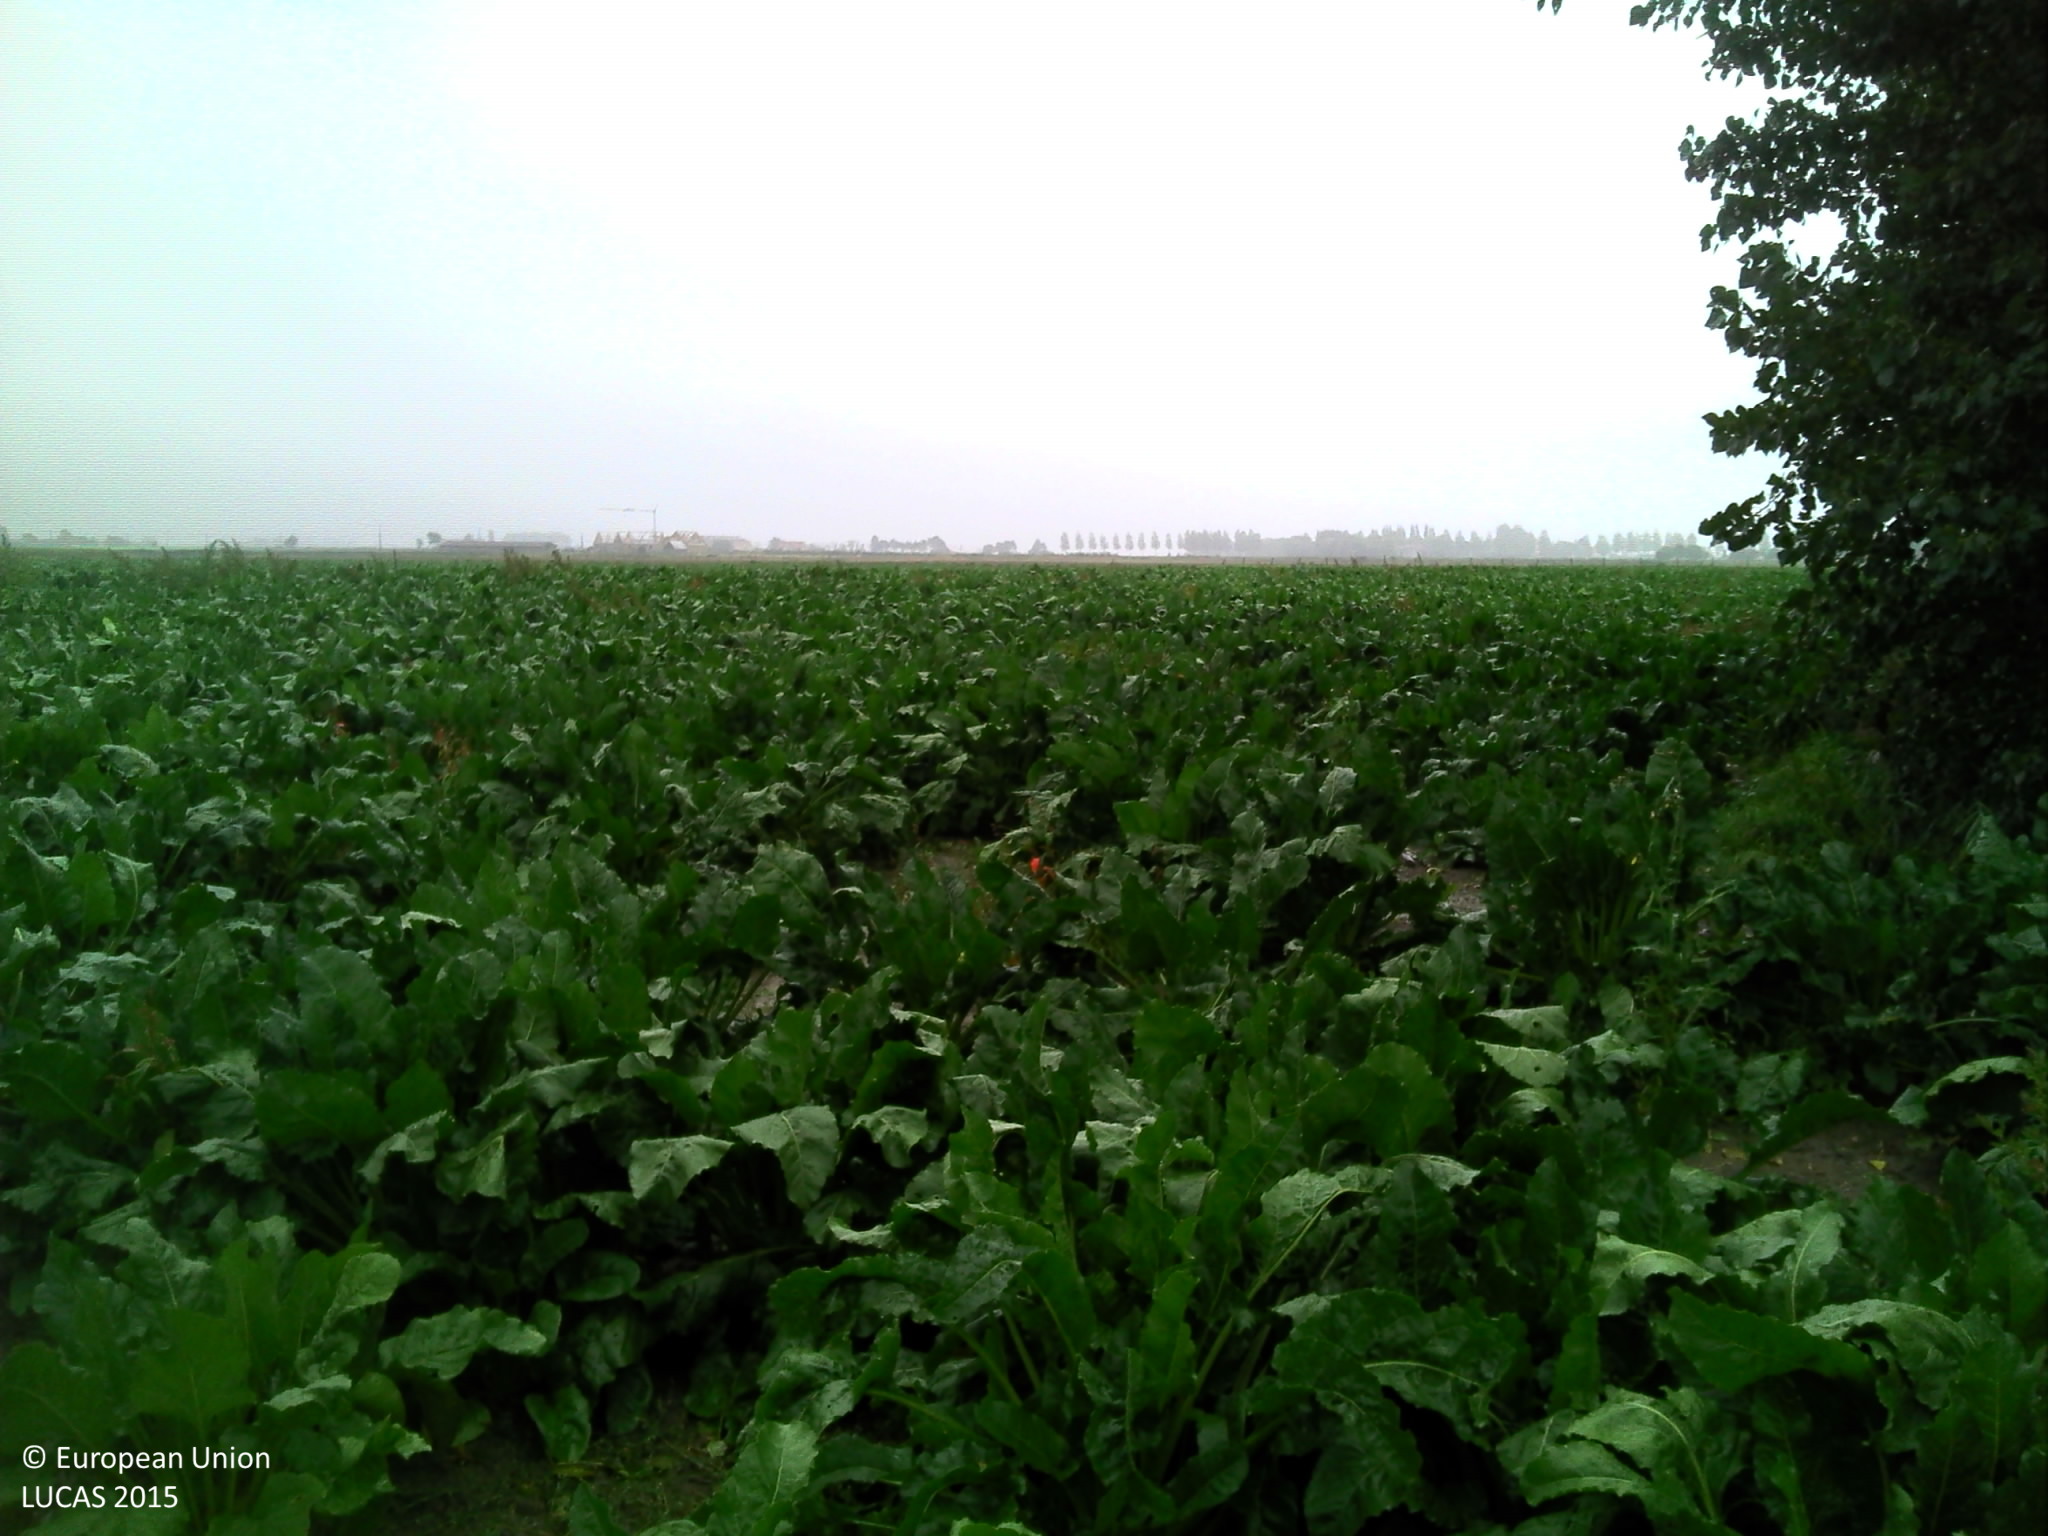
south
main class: Cropland
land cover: Sugar beet
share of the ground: > 75 %
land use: Agriculture (excluding fallow land and kitchen gardens)
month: September
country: BE
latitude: 51.1103
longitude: 2.7754
